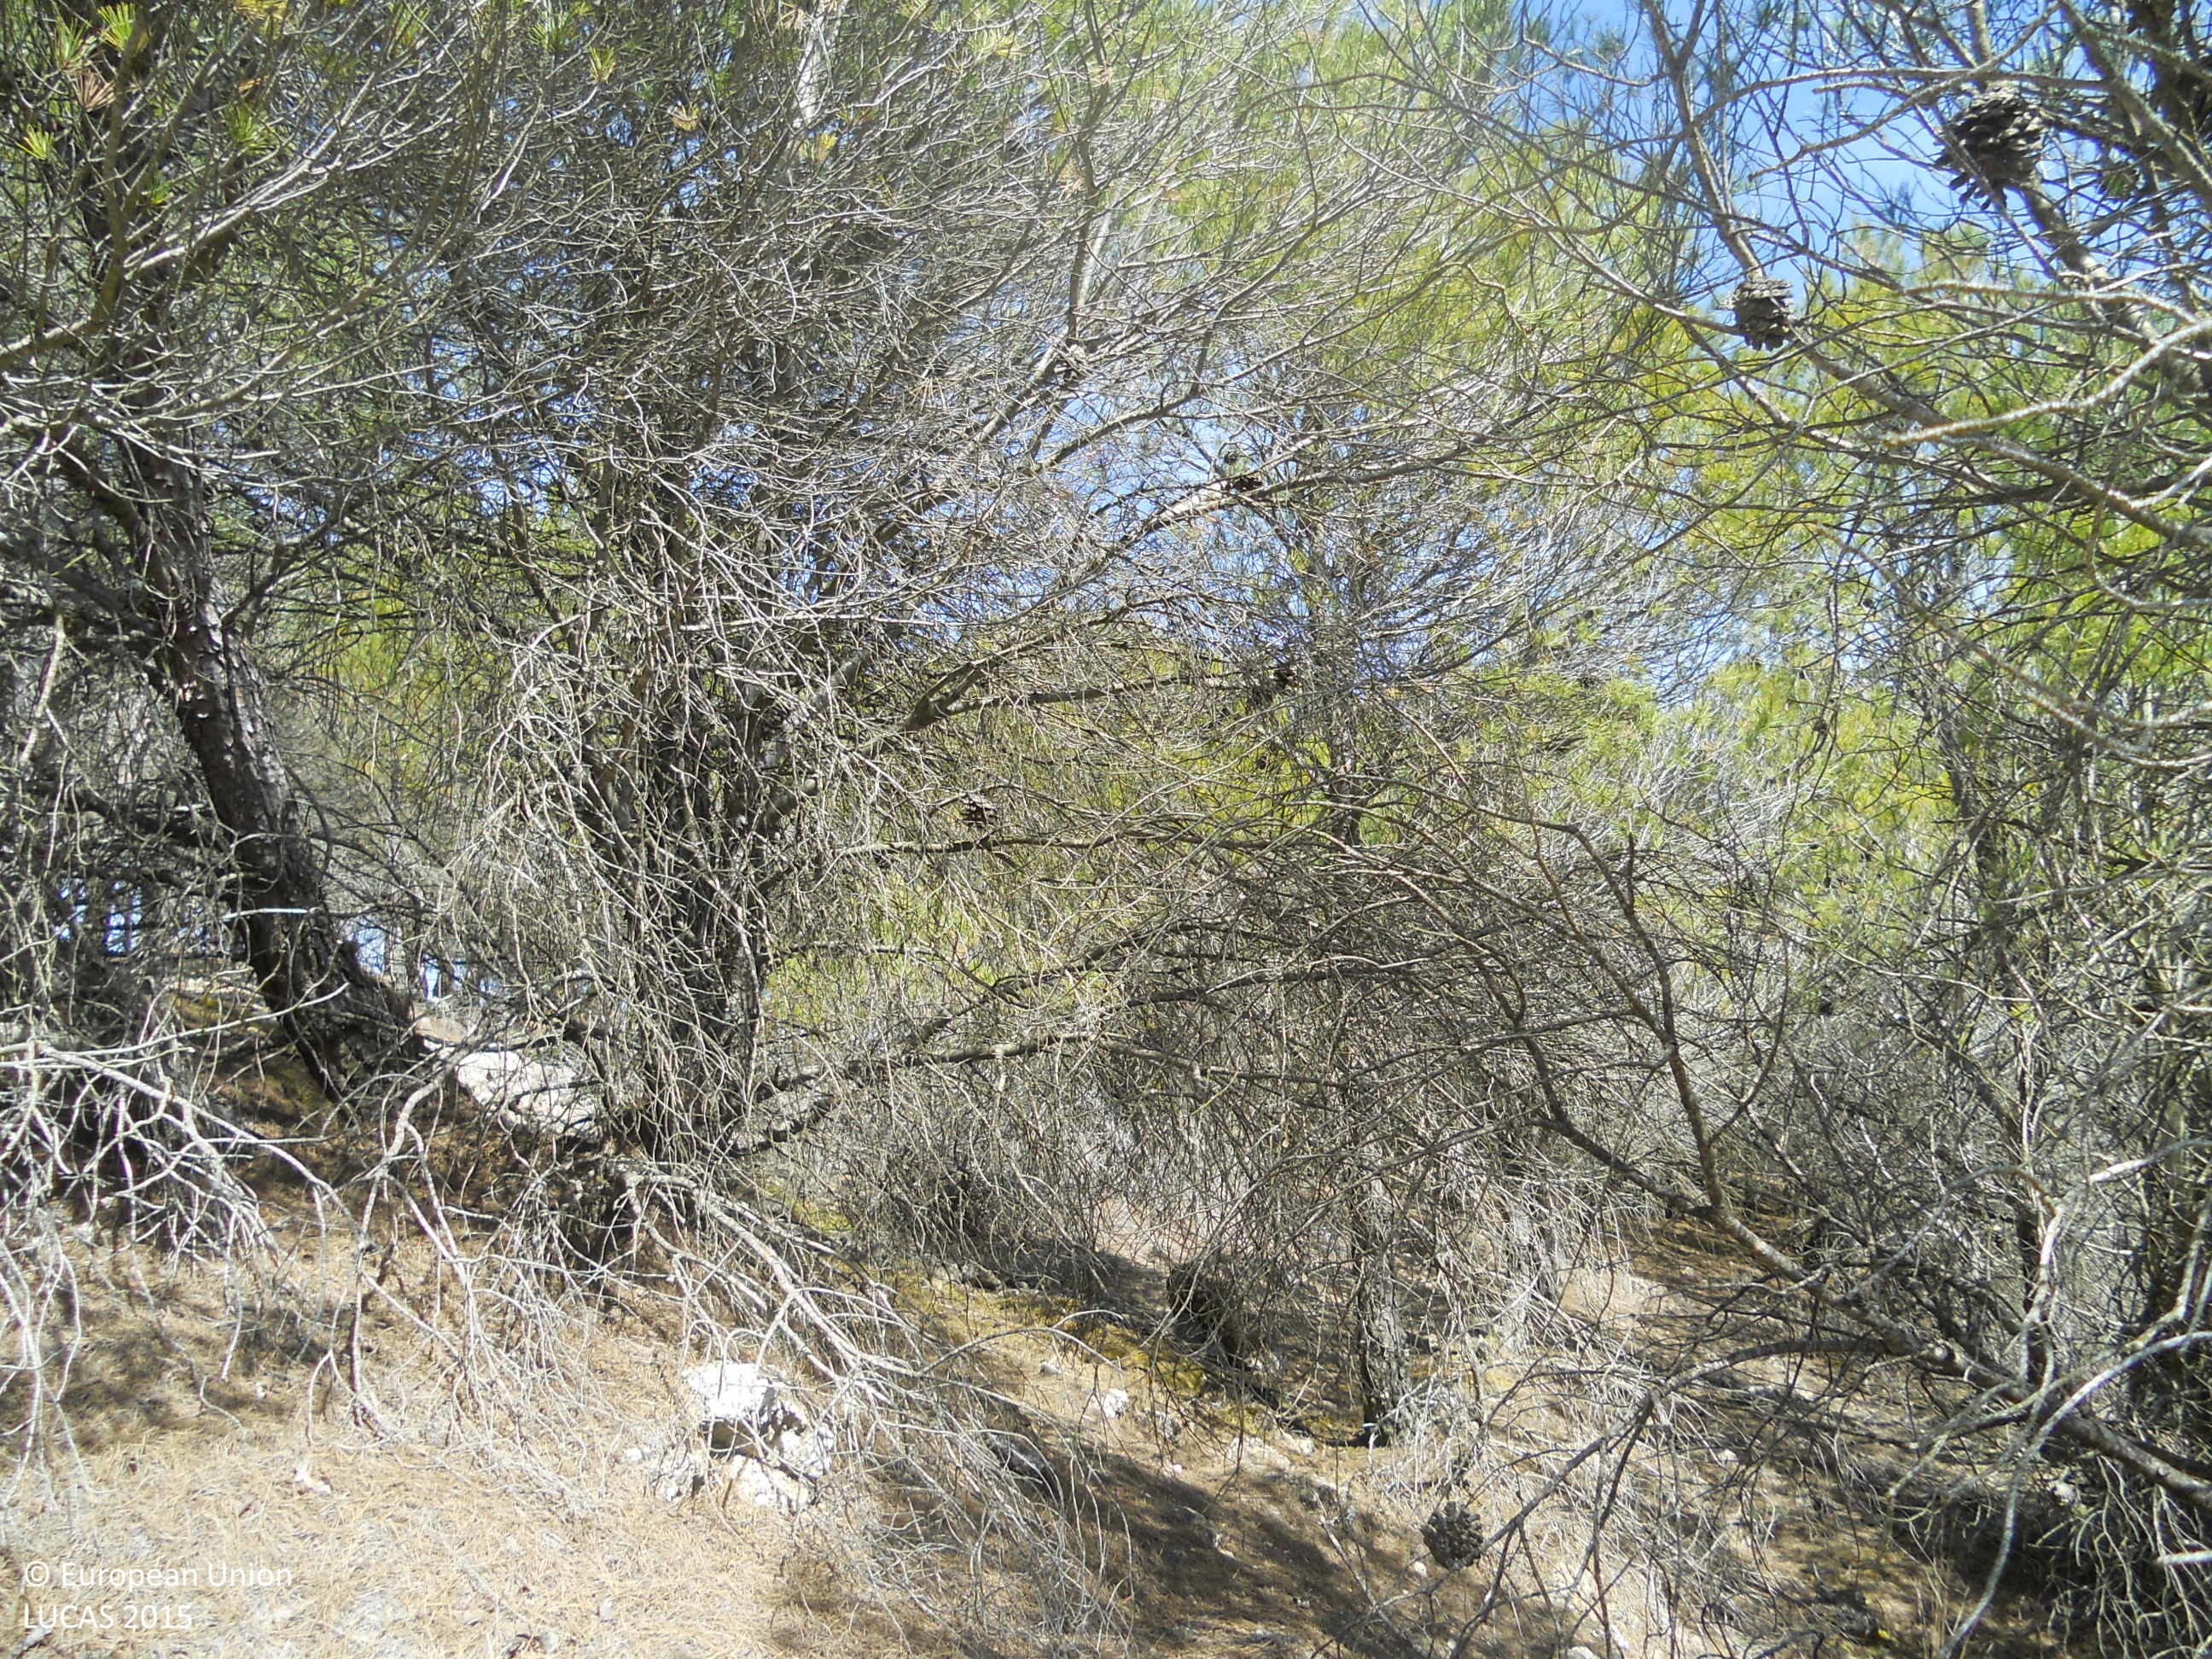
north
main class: Woodland
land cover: Pine dominated coniferous woodland
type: coniferous forest of the mediterranean region
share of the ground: > 75 %
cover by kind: coniferous forest trees 80 %, consolidated bare surface 10 %, herbaceous plants 5 %, unconsolidated bare surface 5 %
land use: Forestry
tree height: > 5 m
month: April
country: ES
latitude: 42.1835
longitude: -4.2947
